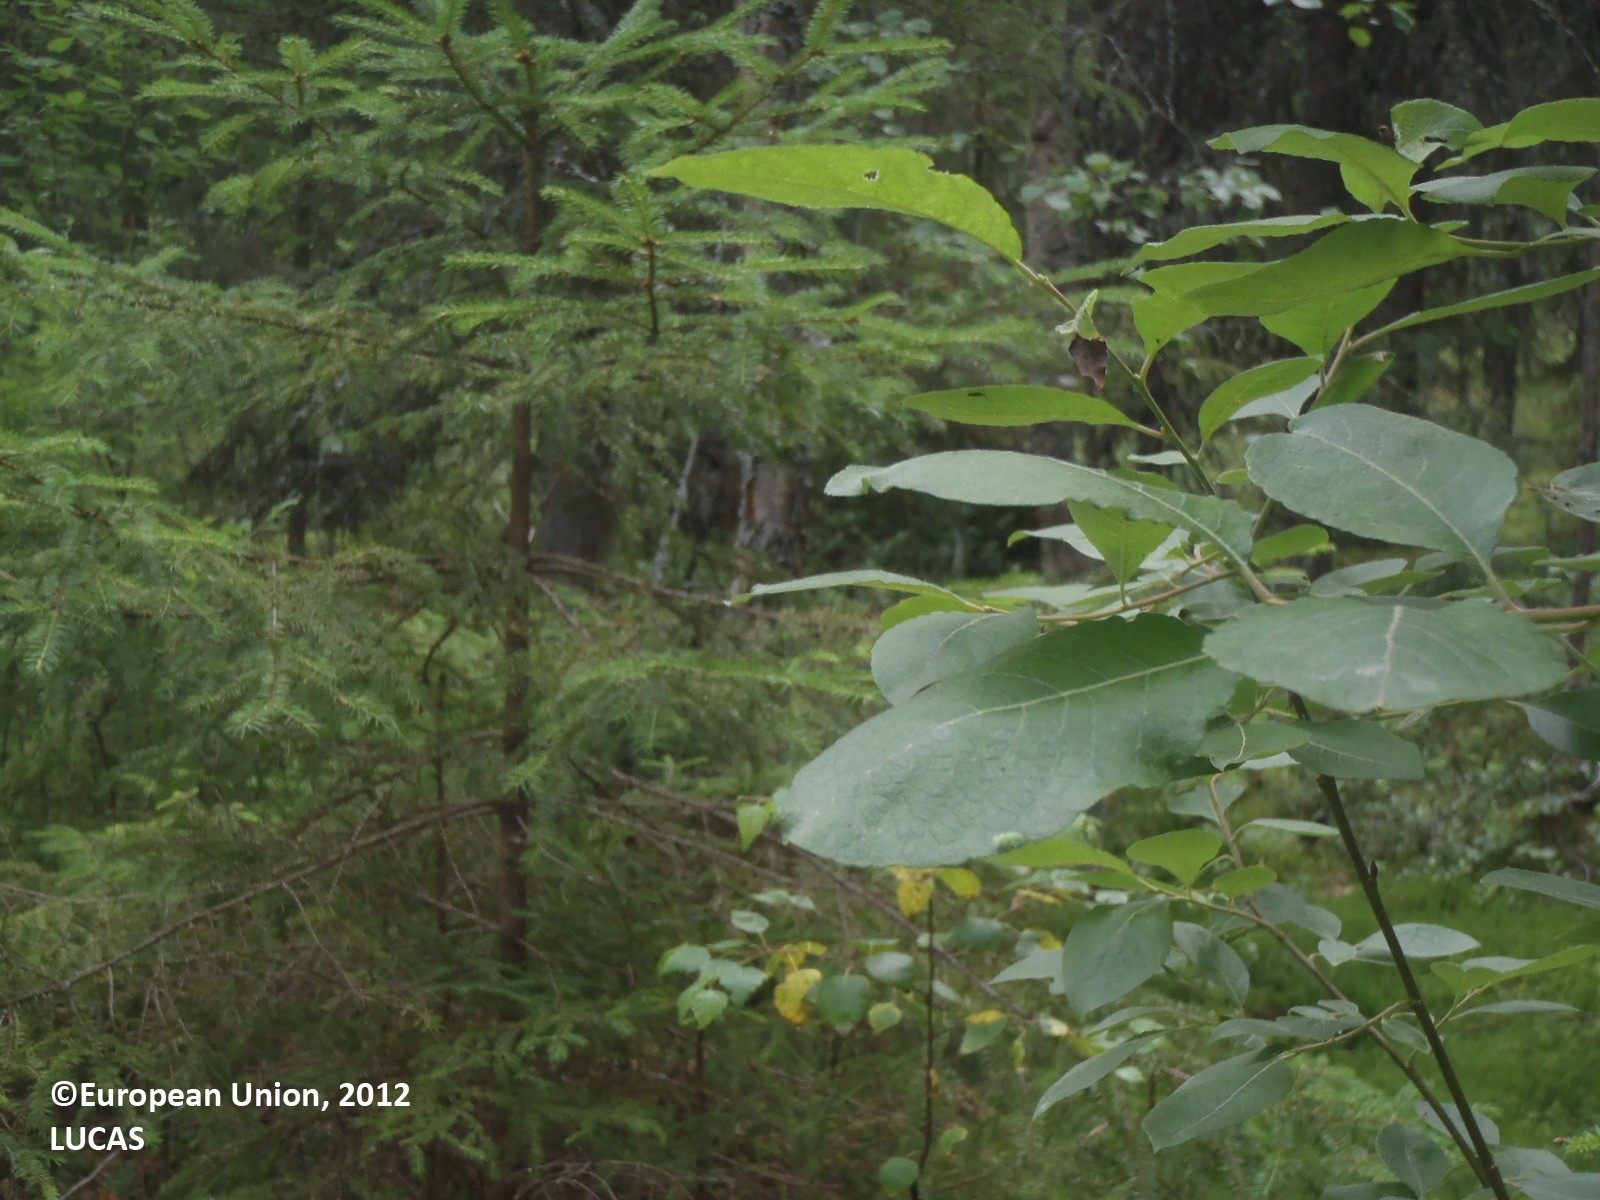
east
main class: Woodland
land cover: Spruce dominated mixed woodland
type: boreal forest
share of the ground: 50 - 75 %
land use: Forestry
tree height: > 5 m
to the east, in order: Spruce dominated mixed woodland; Ditches and canals; Grass margins; Paved roads, cycling and walking lanes; Grass margins; Pine dominated mixed woodland; Ditches and canals; Pine dominated mixed woodland; Pine dominated coniferous woodland; Grassland with sparse tree/shrub cover
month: July
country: FI
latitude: 60.9760
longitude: 21.8276
